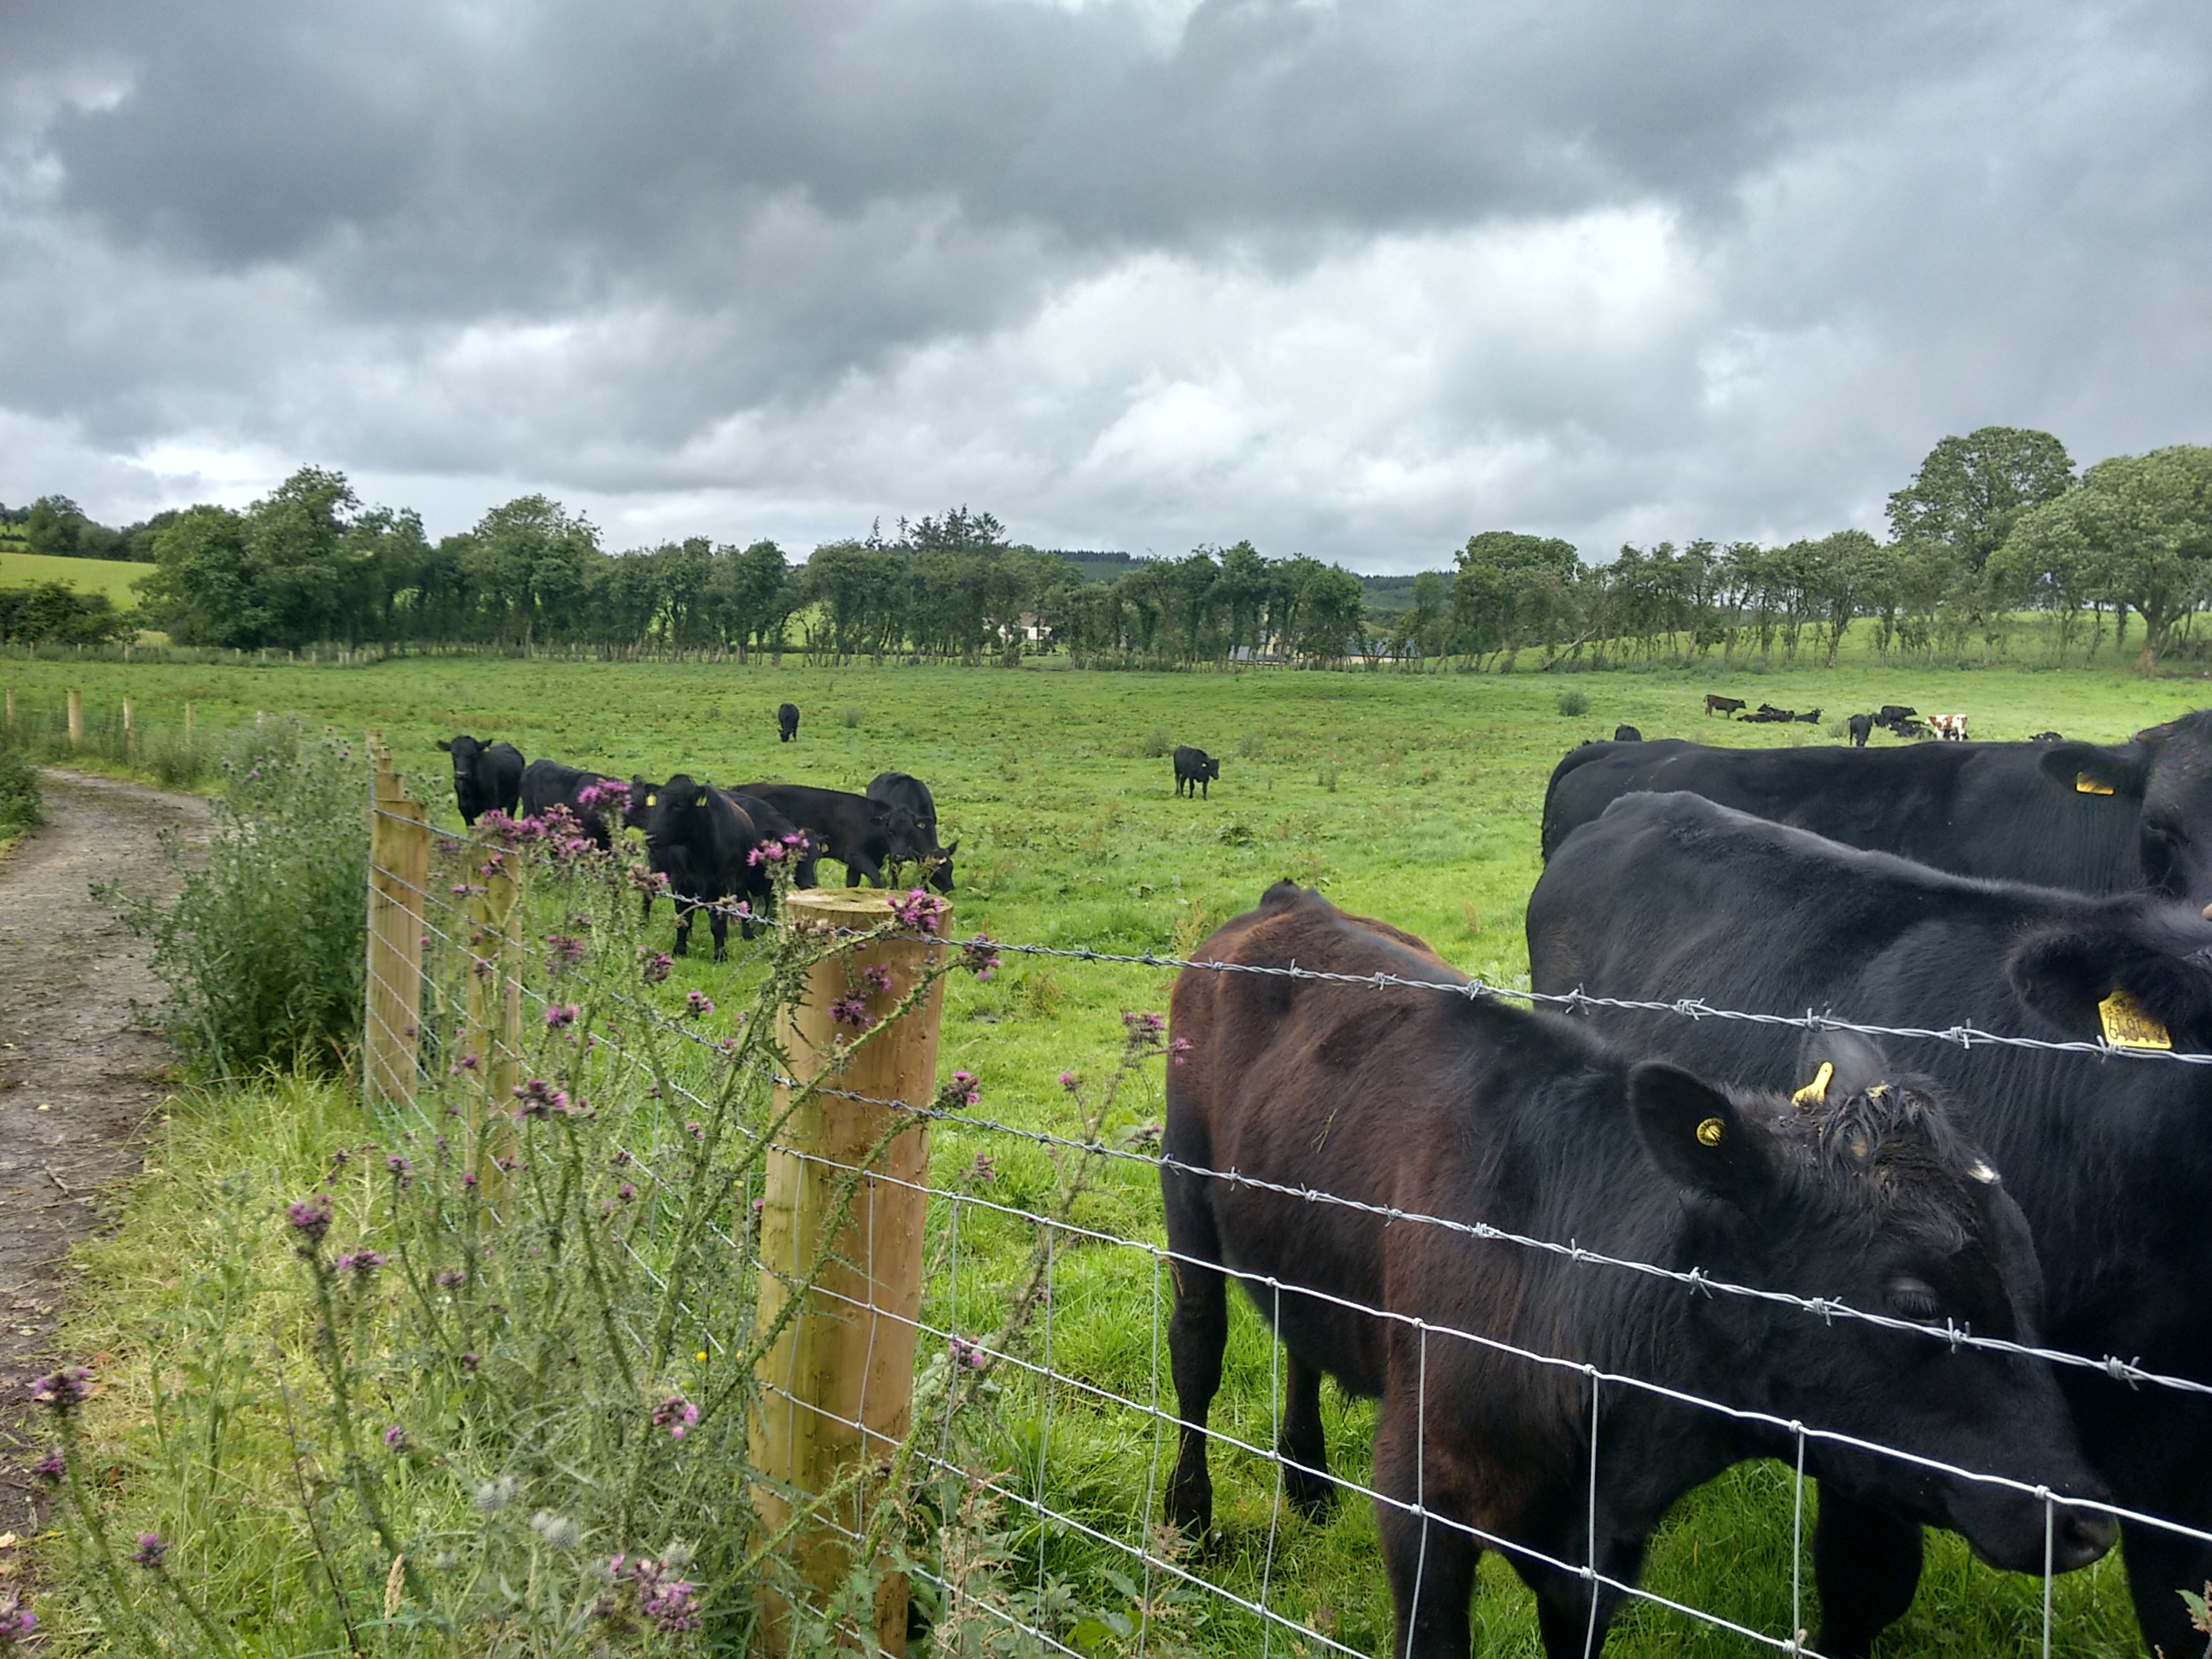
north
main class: Grassland
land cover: Grassland without tree/shrub cover
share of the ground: > 75 %
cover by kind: herbaceous plants 100 %
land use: Agriculture (excluding fallow land and kitchen gardens)
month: July
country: GB
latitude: 54.4005
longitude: -7.3576
